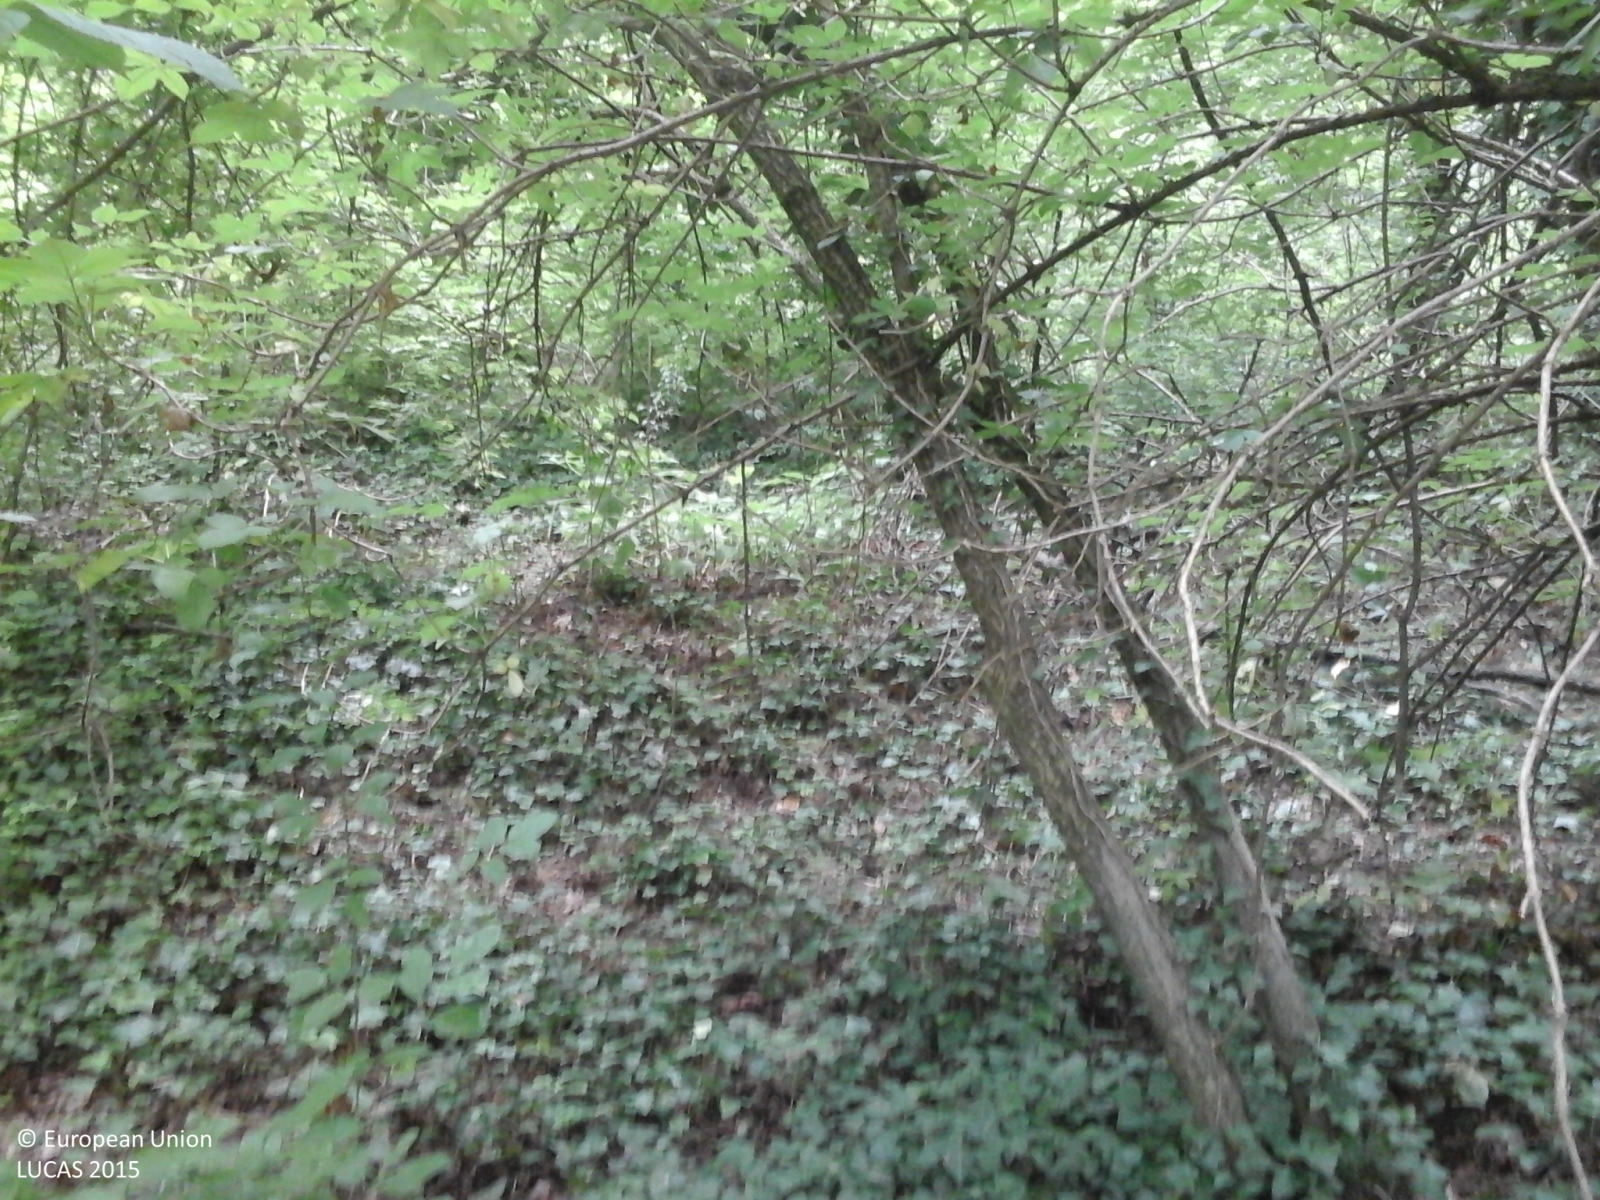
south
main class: Woodland
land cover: Broadleaved woodland
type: thermophilous deciduous forest
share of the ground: > 75 %
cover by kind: broadleaved forest trees 100 %
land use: Forestry
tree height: > 5 m
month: June
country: IT
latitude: 45.1480
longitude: 8.2861
